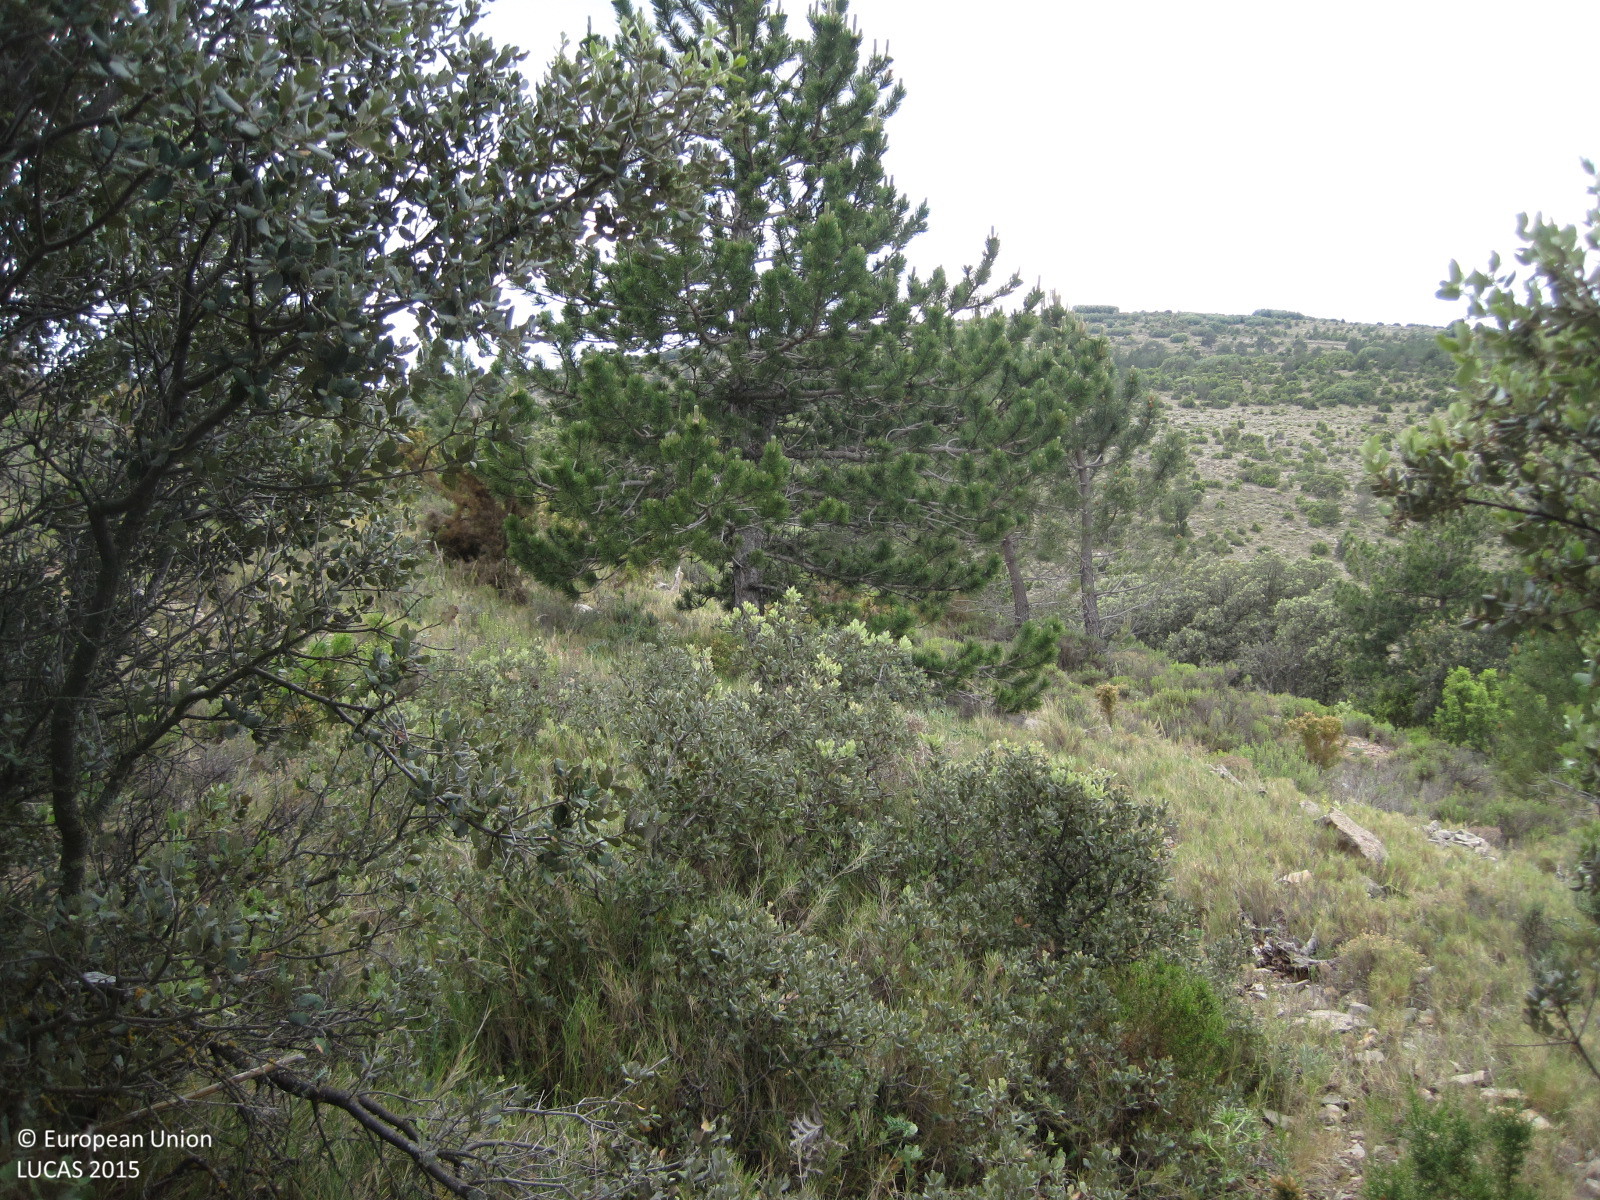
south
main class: Woodland
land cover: Pine dominated coniferous woodland
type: coniferous forest of the mediterranean region
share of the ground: 10 - 25 %
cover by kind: coniferous forest trees 40 %, shrubs 20 %, herbaceous plants 20 %, broadleaved forest trees 10 %, consolidated bare surface 10 %
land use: Forestry
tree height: > 5 m
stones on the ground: 25 - 50 %
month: May
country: ES
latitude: 39.8783
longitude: -0.7254
